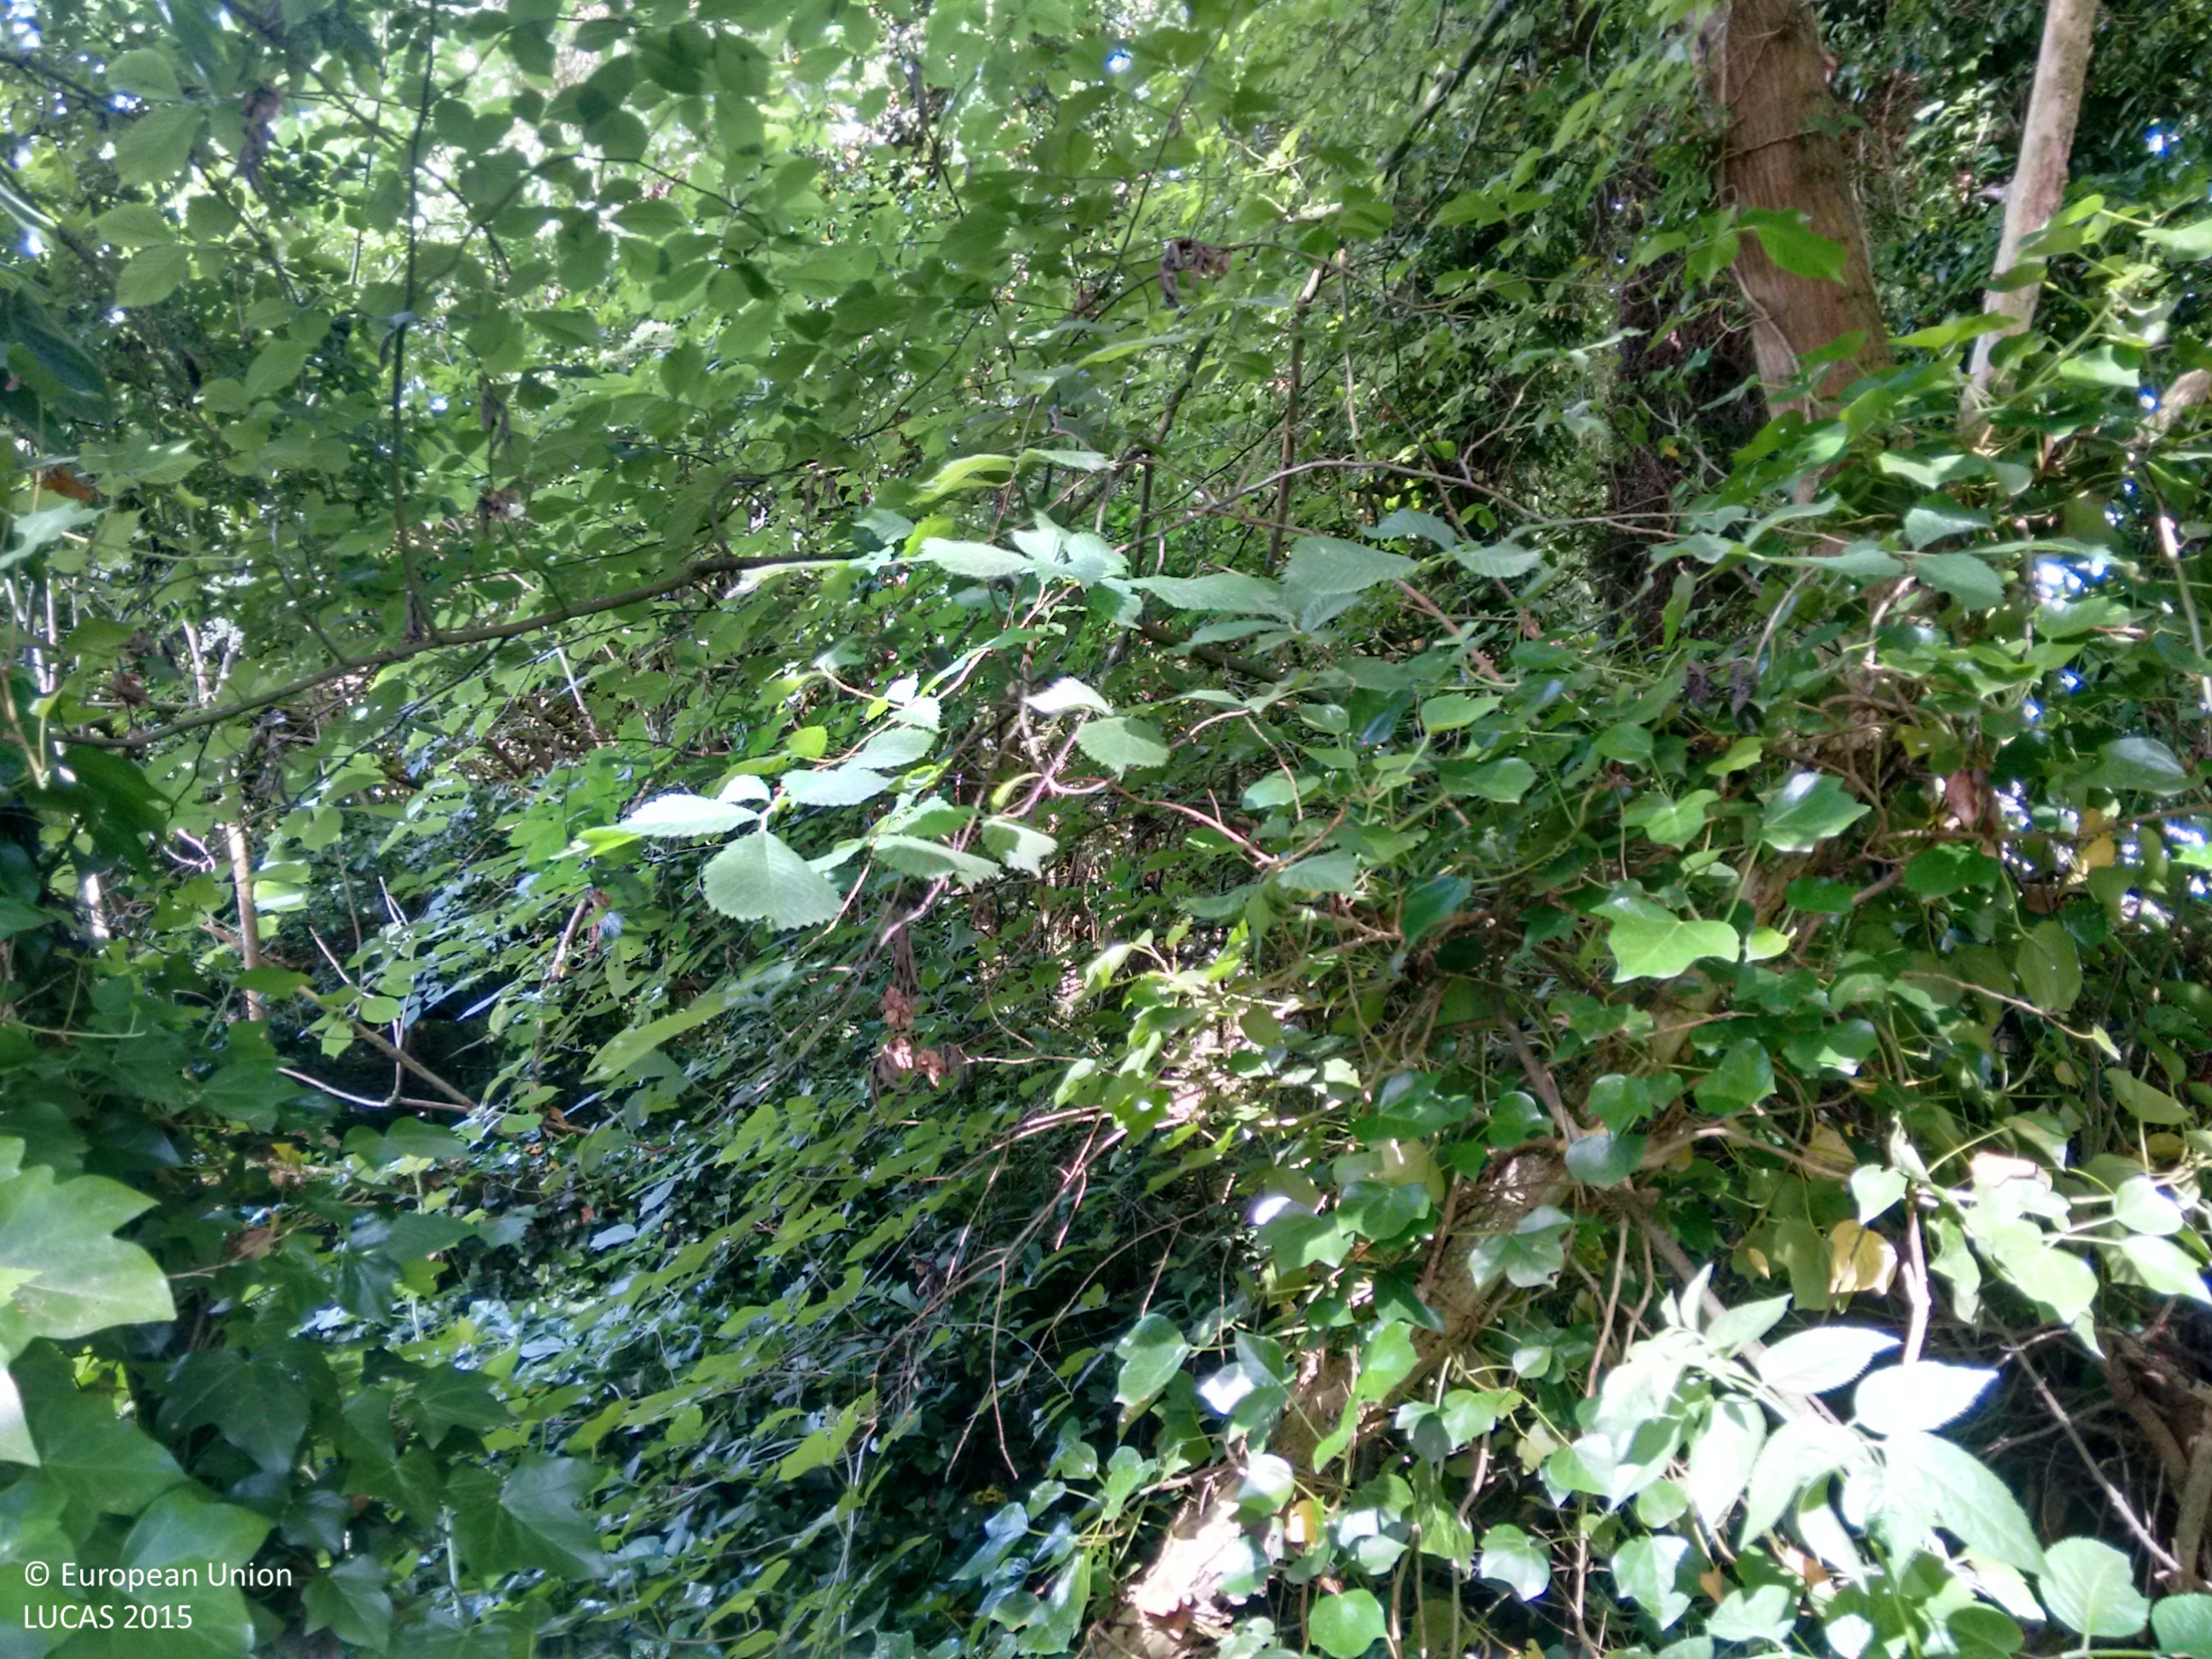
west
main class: Woodland
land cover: Broadleaved woodland
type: mesophytic deciduous forest
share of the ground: > 75 %
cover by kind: broadleaved forest trees 60 %, coniferous forest trees 20 %, shrubs 20 %
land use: Semi-natural and natural areas not in use
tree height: > 5 m
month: June
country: IE
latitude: 53.6987
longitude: -6.7181
